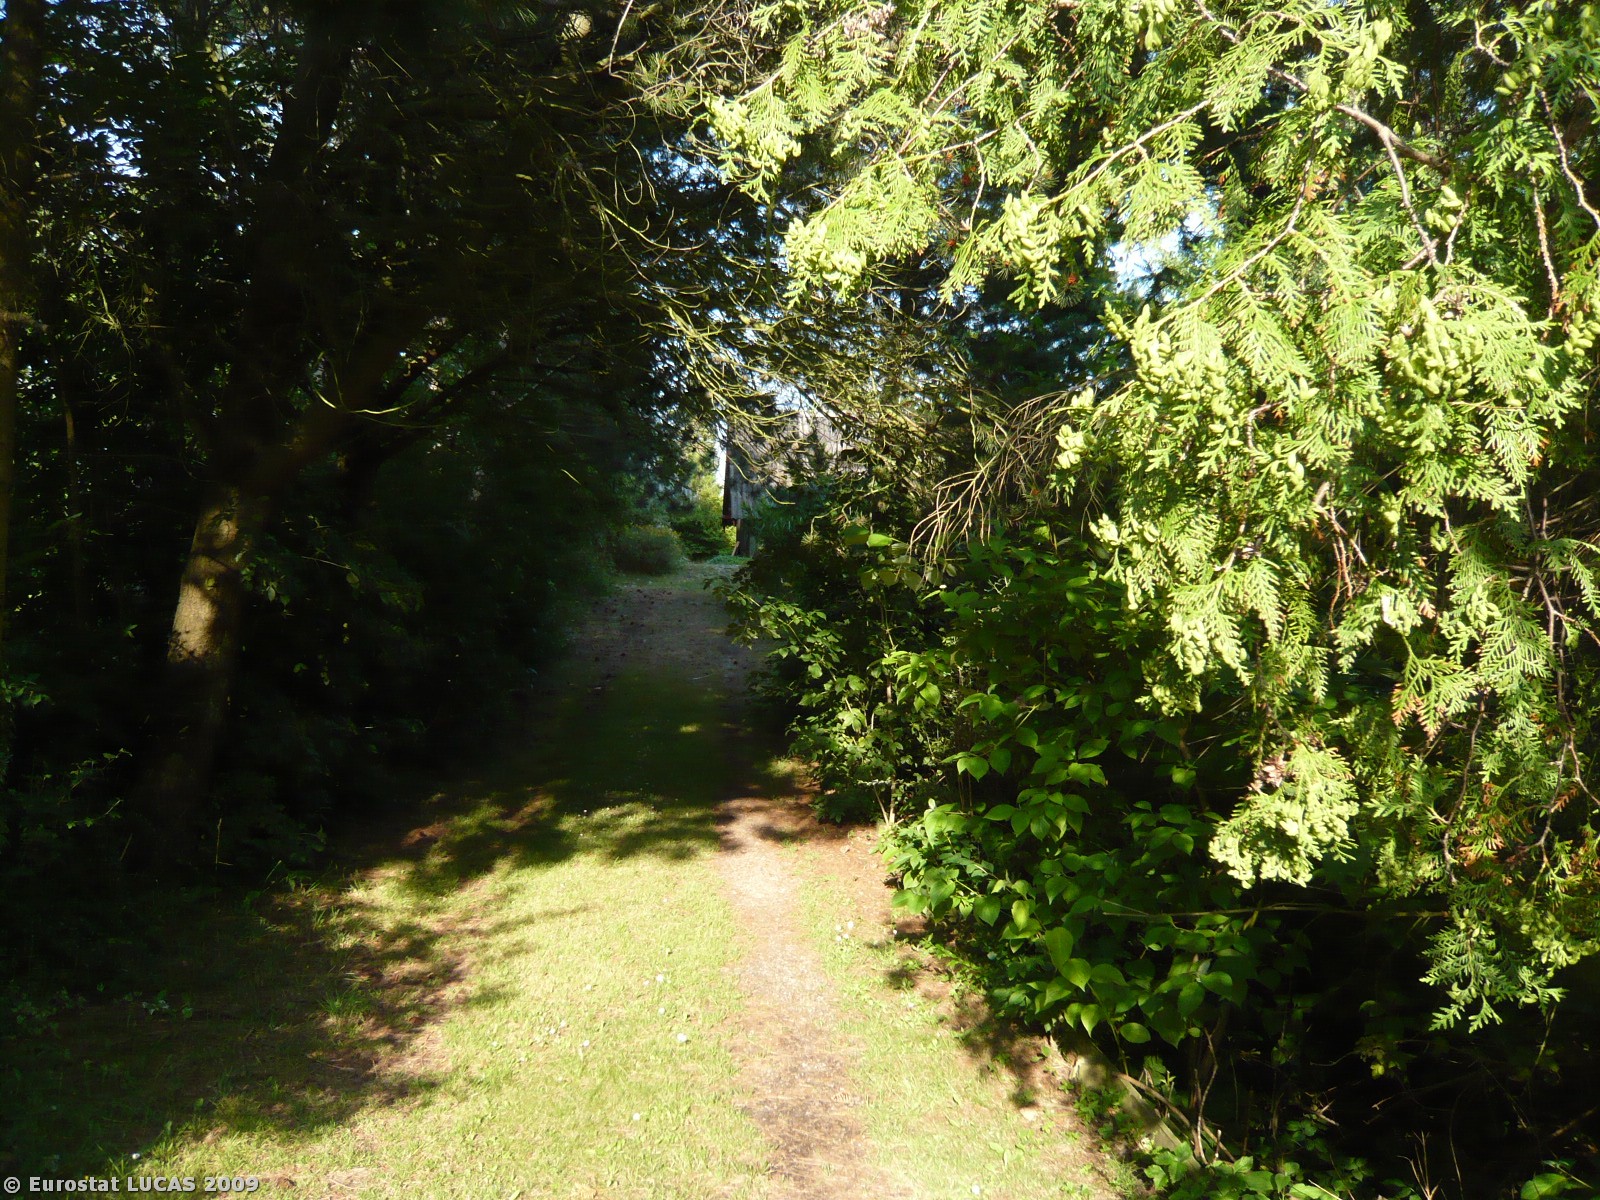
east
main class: Woodland
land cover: Coniferous woodland
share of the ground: > 75 %
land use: Holiday camps
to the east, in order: Coniferous woodland; Artificial constructions in urban areas; Managed hedges; Grassland without tree/shrub cover; Inland marshes
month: July
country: DK
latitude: 55.7997
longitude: 11.6415
